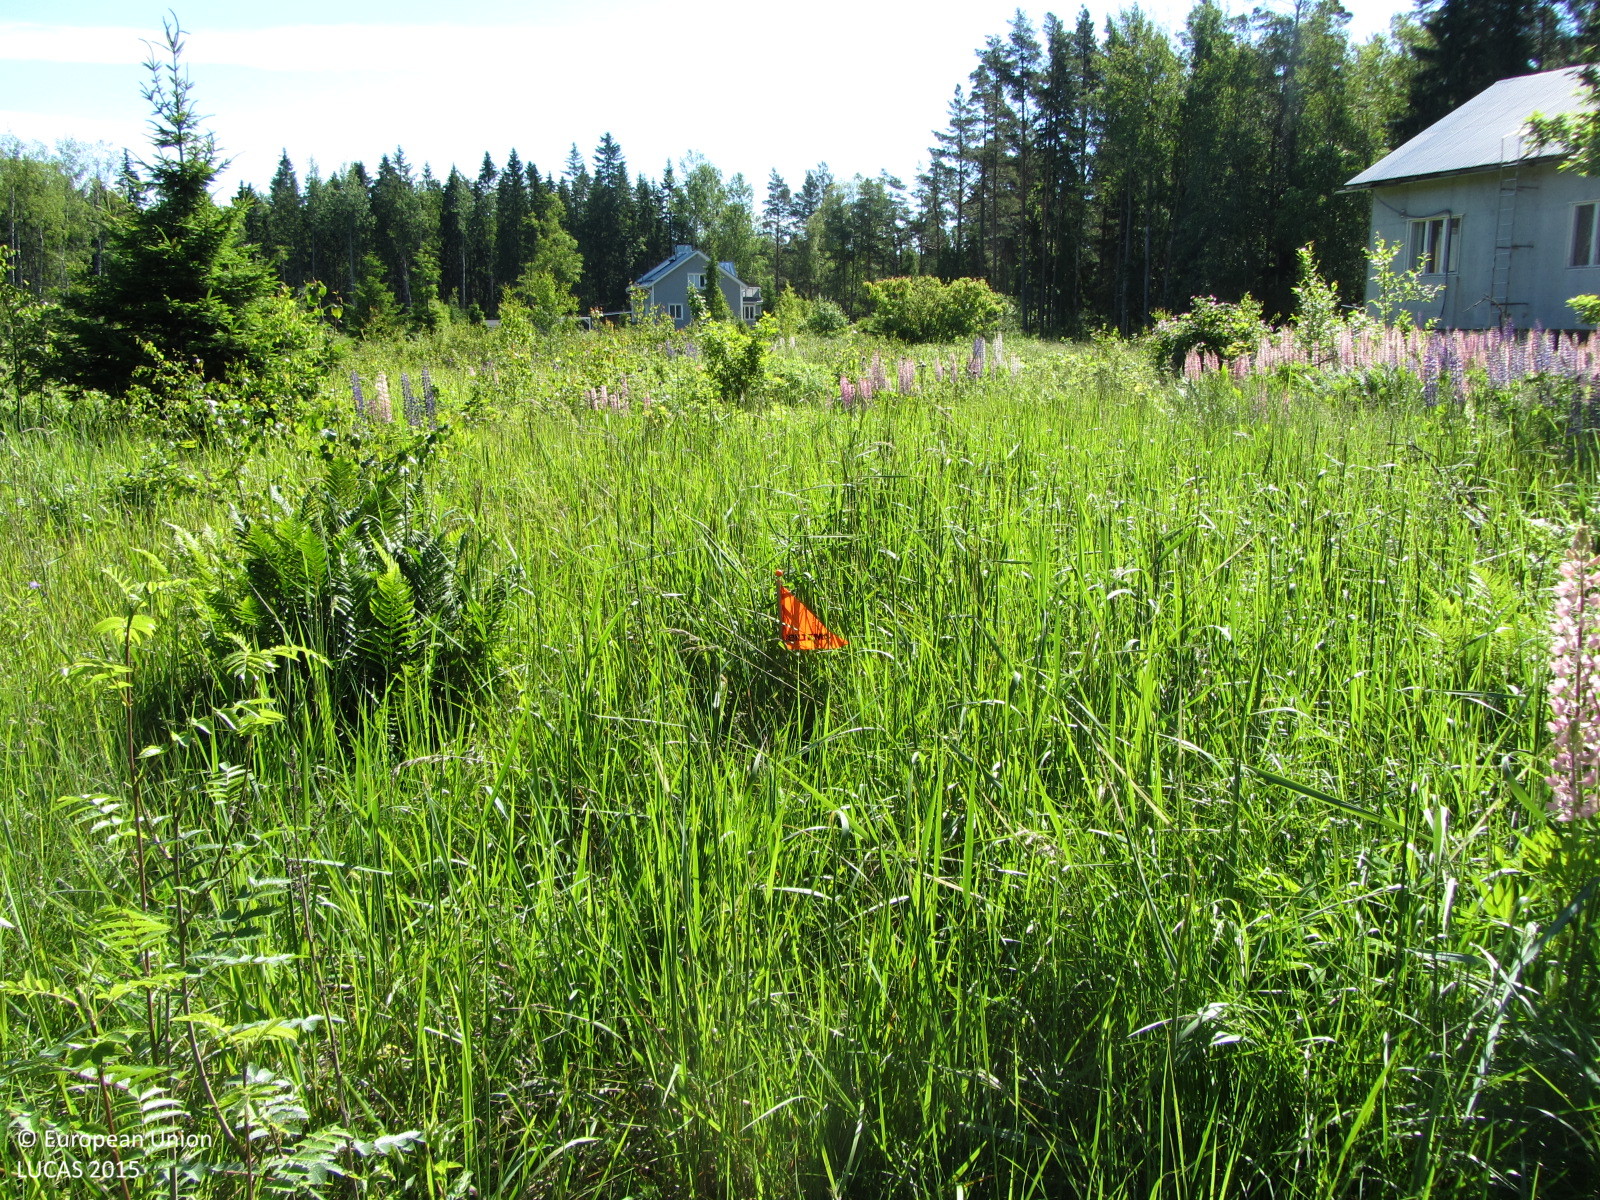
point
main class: Grassland
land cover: Grassland with sparse tree/shrub cover
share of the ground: > 75 %
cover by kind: herbaceous plants 90 %, broadleaved forest trees 5 %, shrubs 5 %
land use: Residential
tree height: < 5 m
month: July
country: FI
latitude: 59.8412
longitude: 23.0926
